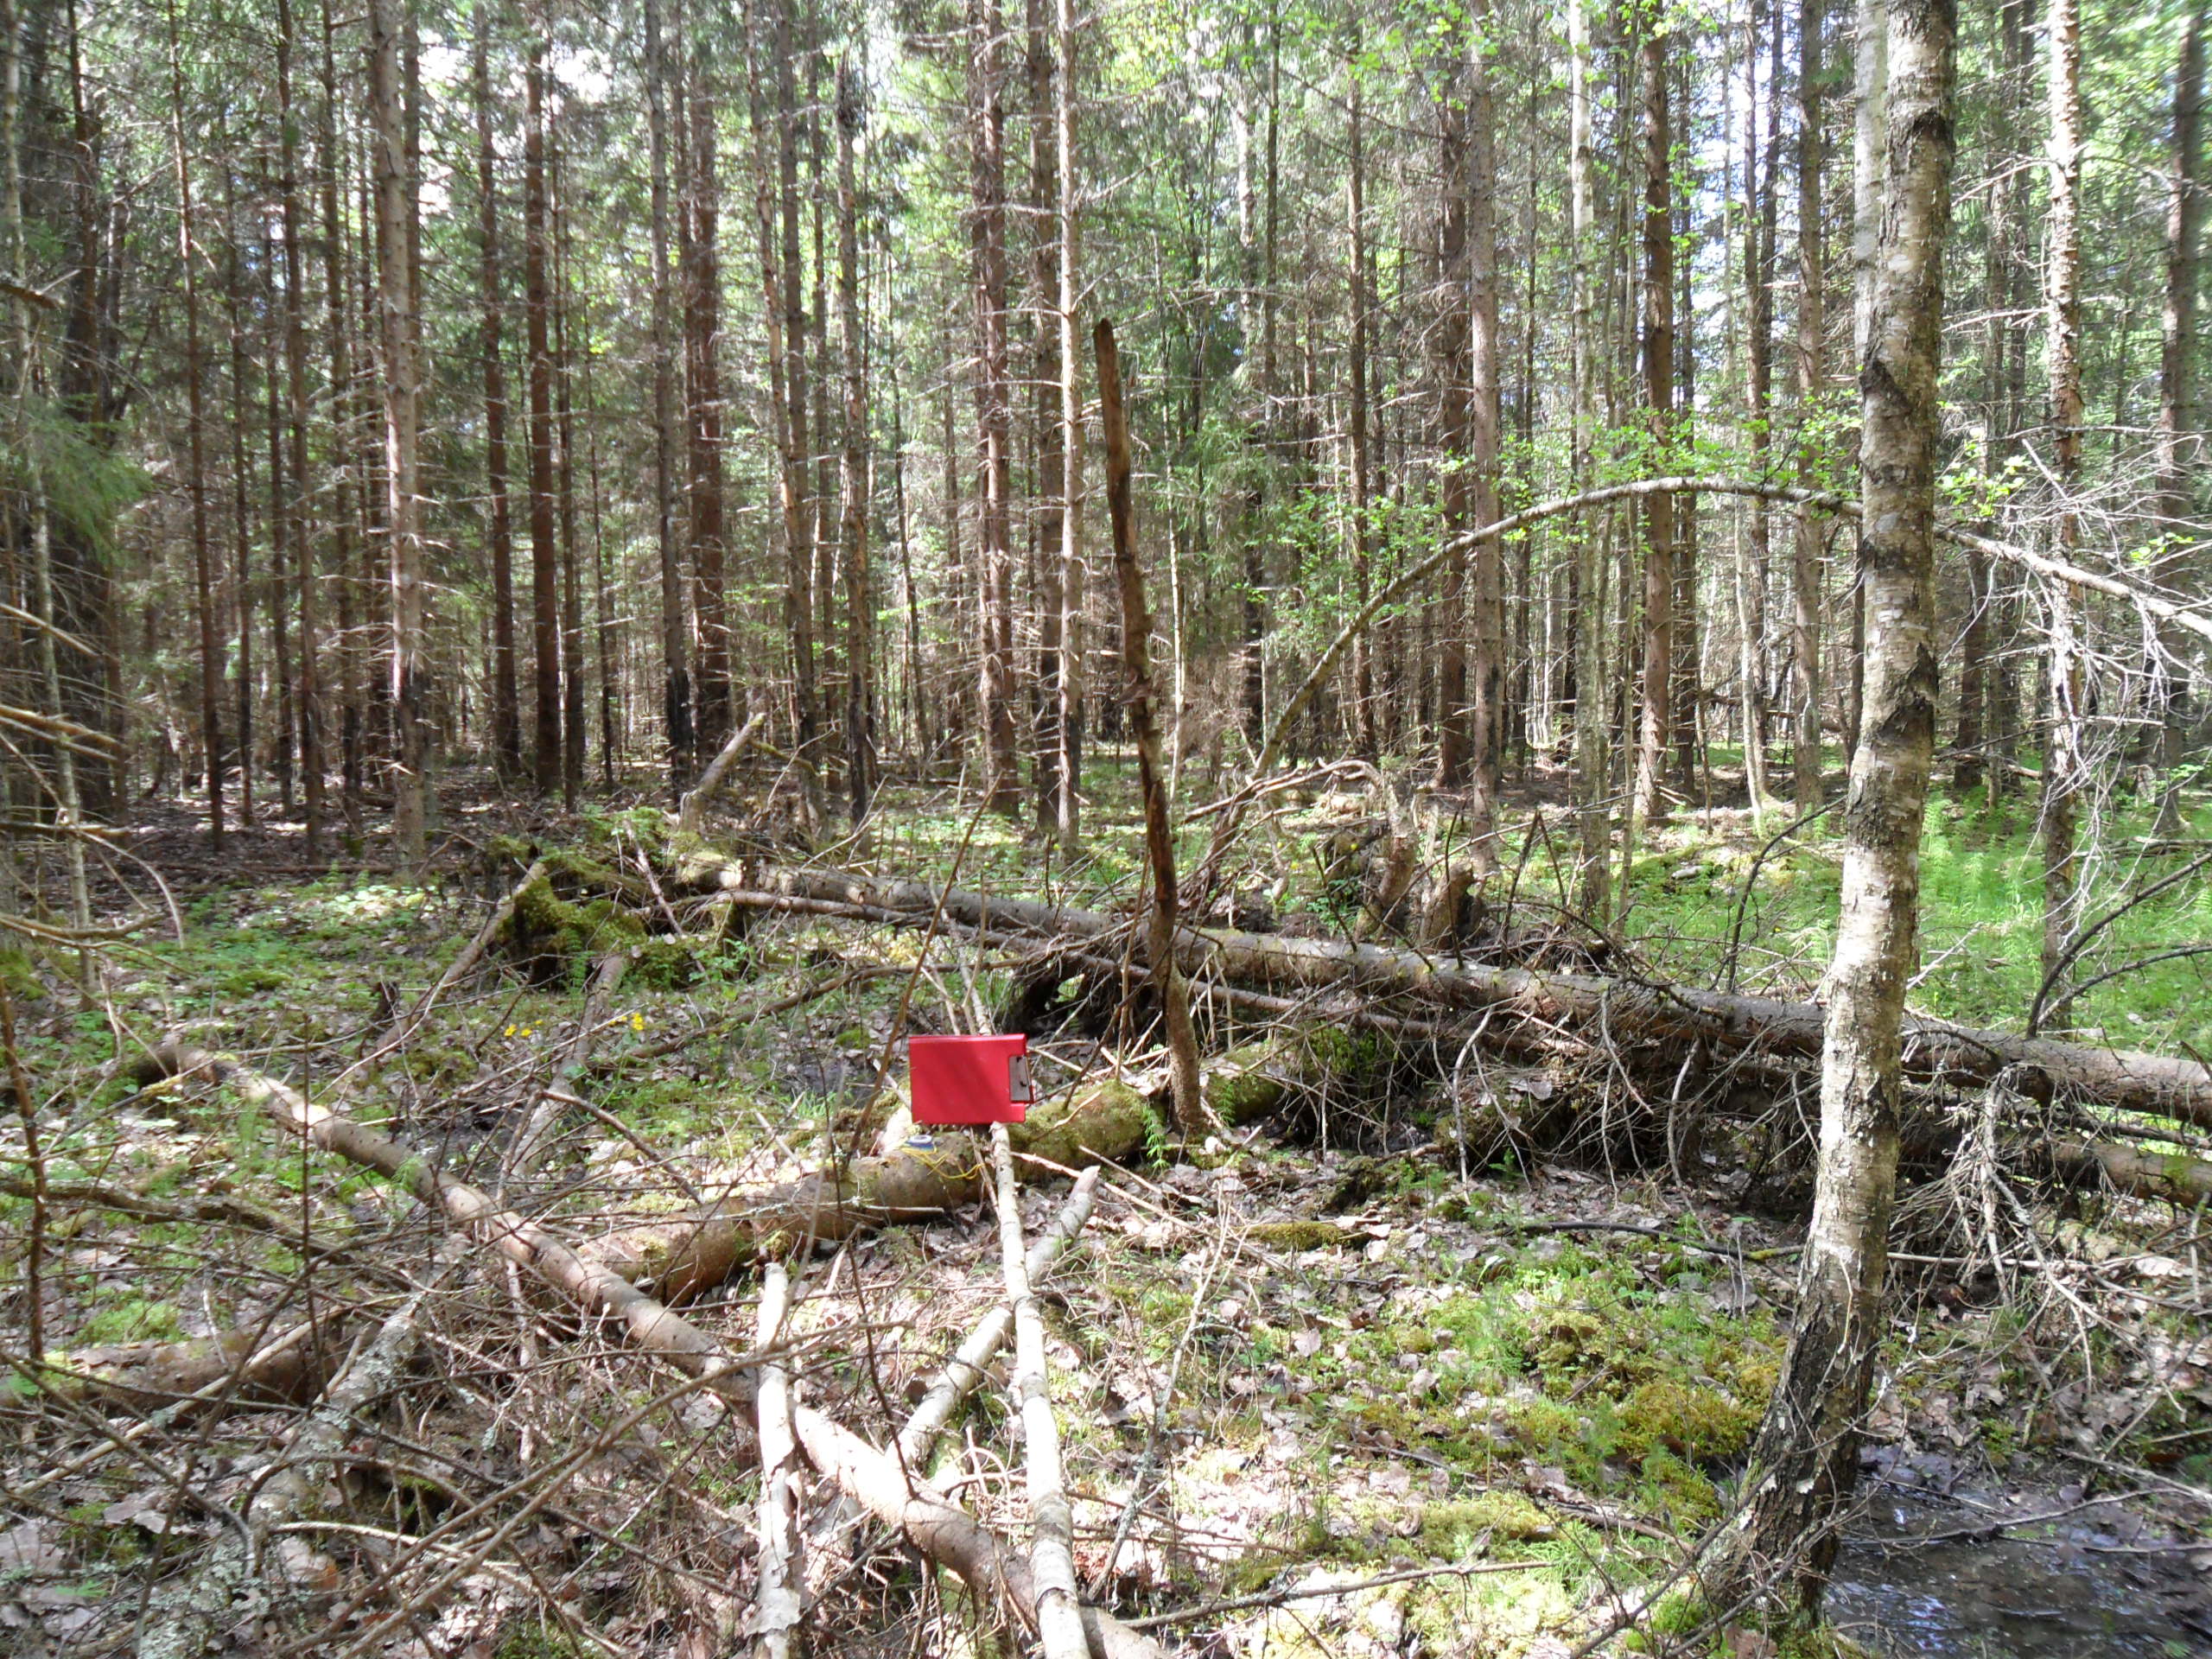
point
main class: Woodland
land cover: Spruce dominated mixed woodland
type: hemiboreal forest and nemoral coniferous forest and mixed broadleaved-coniferous forest
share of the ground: > 75 %
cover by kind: coniferous forest trees 60 %, broadleaved forest trees 40 %
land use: Forestry
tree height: > 5 m
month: May
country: LV
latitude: 57.2739
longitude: 22.4417
